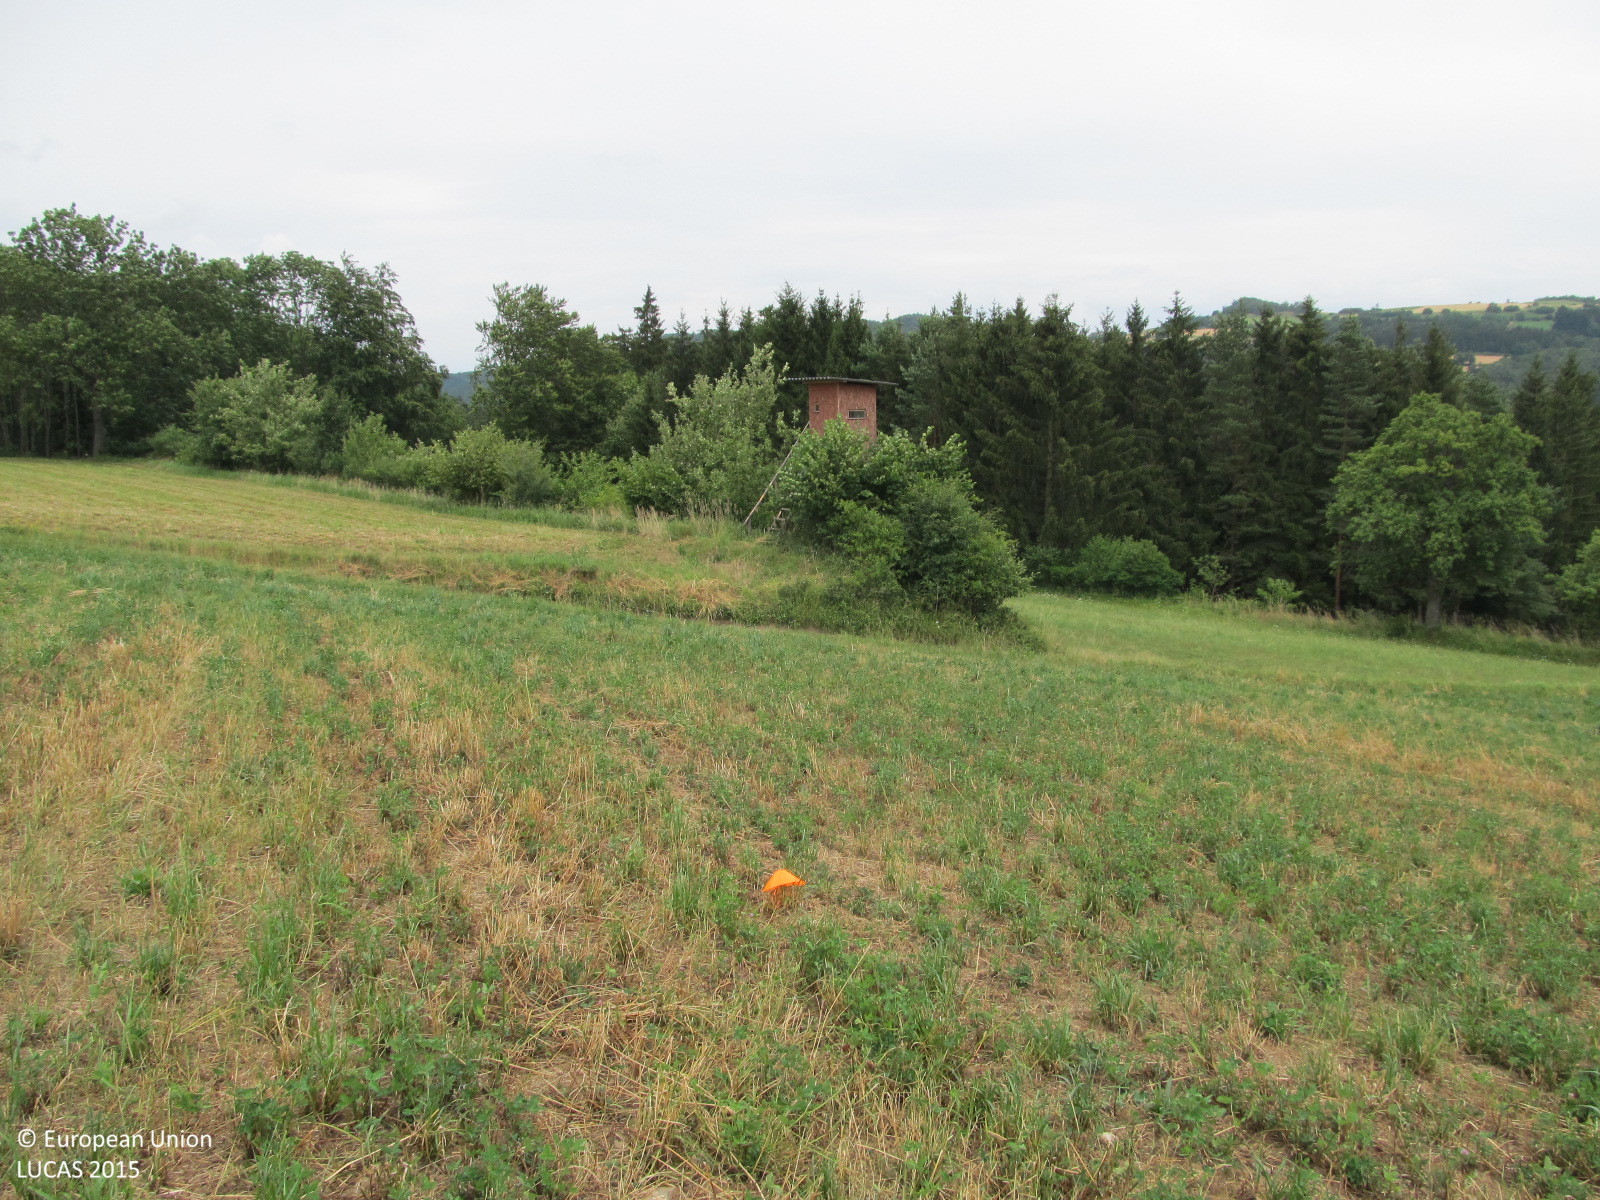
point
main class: Cropland
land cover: Temporary grasslands
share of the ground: > 75 %
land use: Agriculture (excluding fallow land and kitchen gardens)
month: July
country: AT
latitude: 48.4494
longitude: 15.4512
